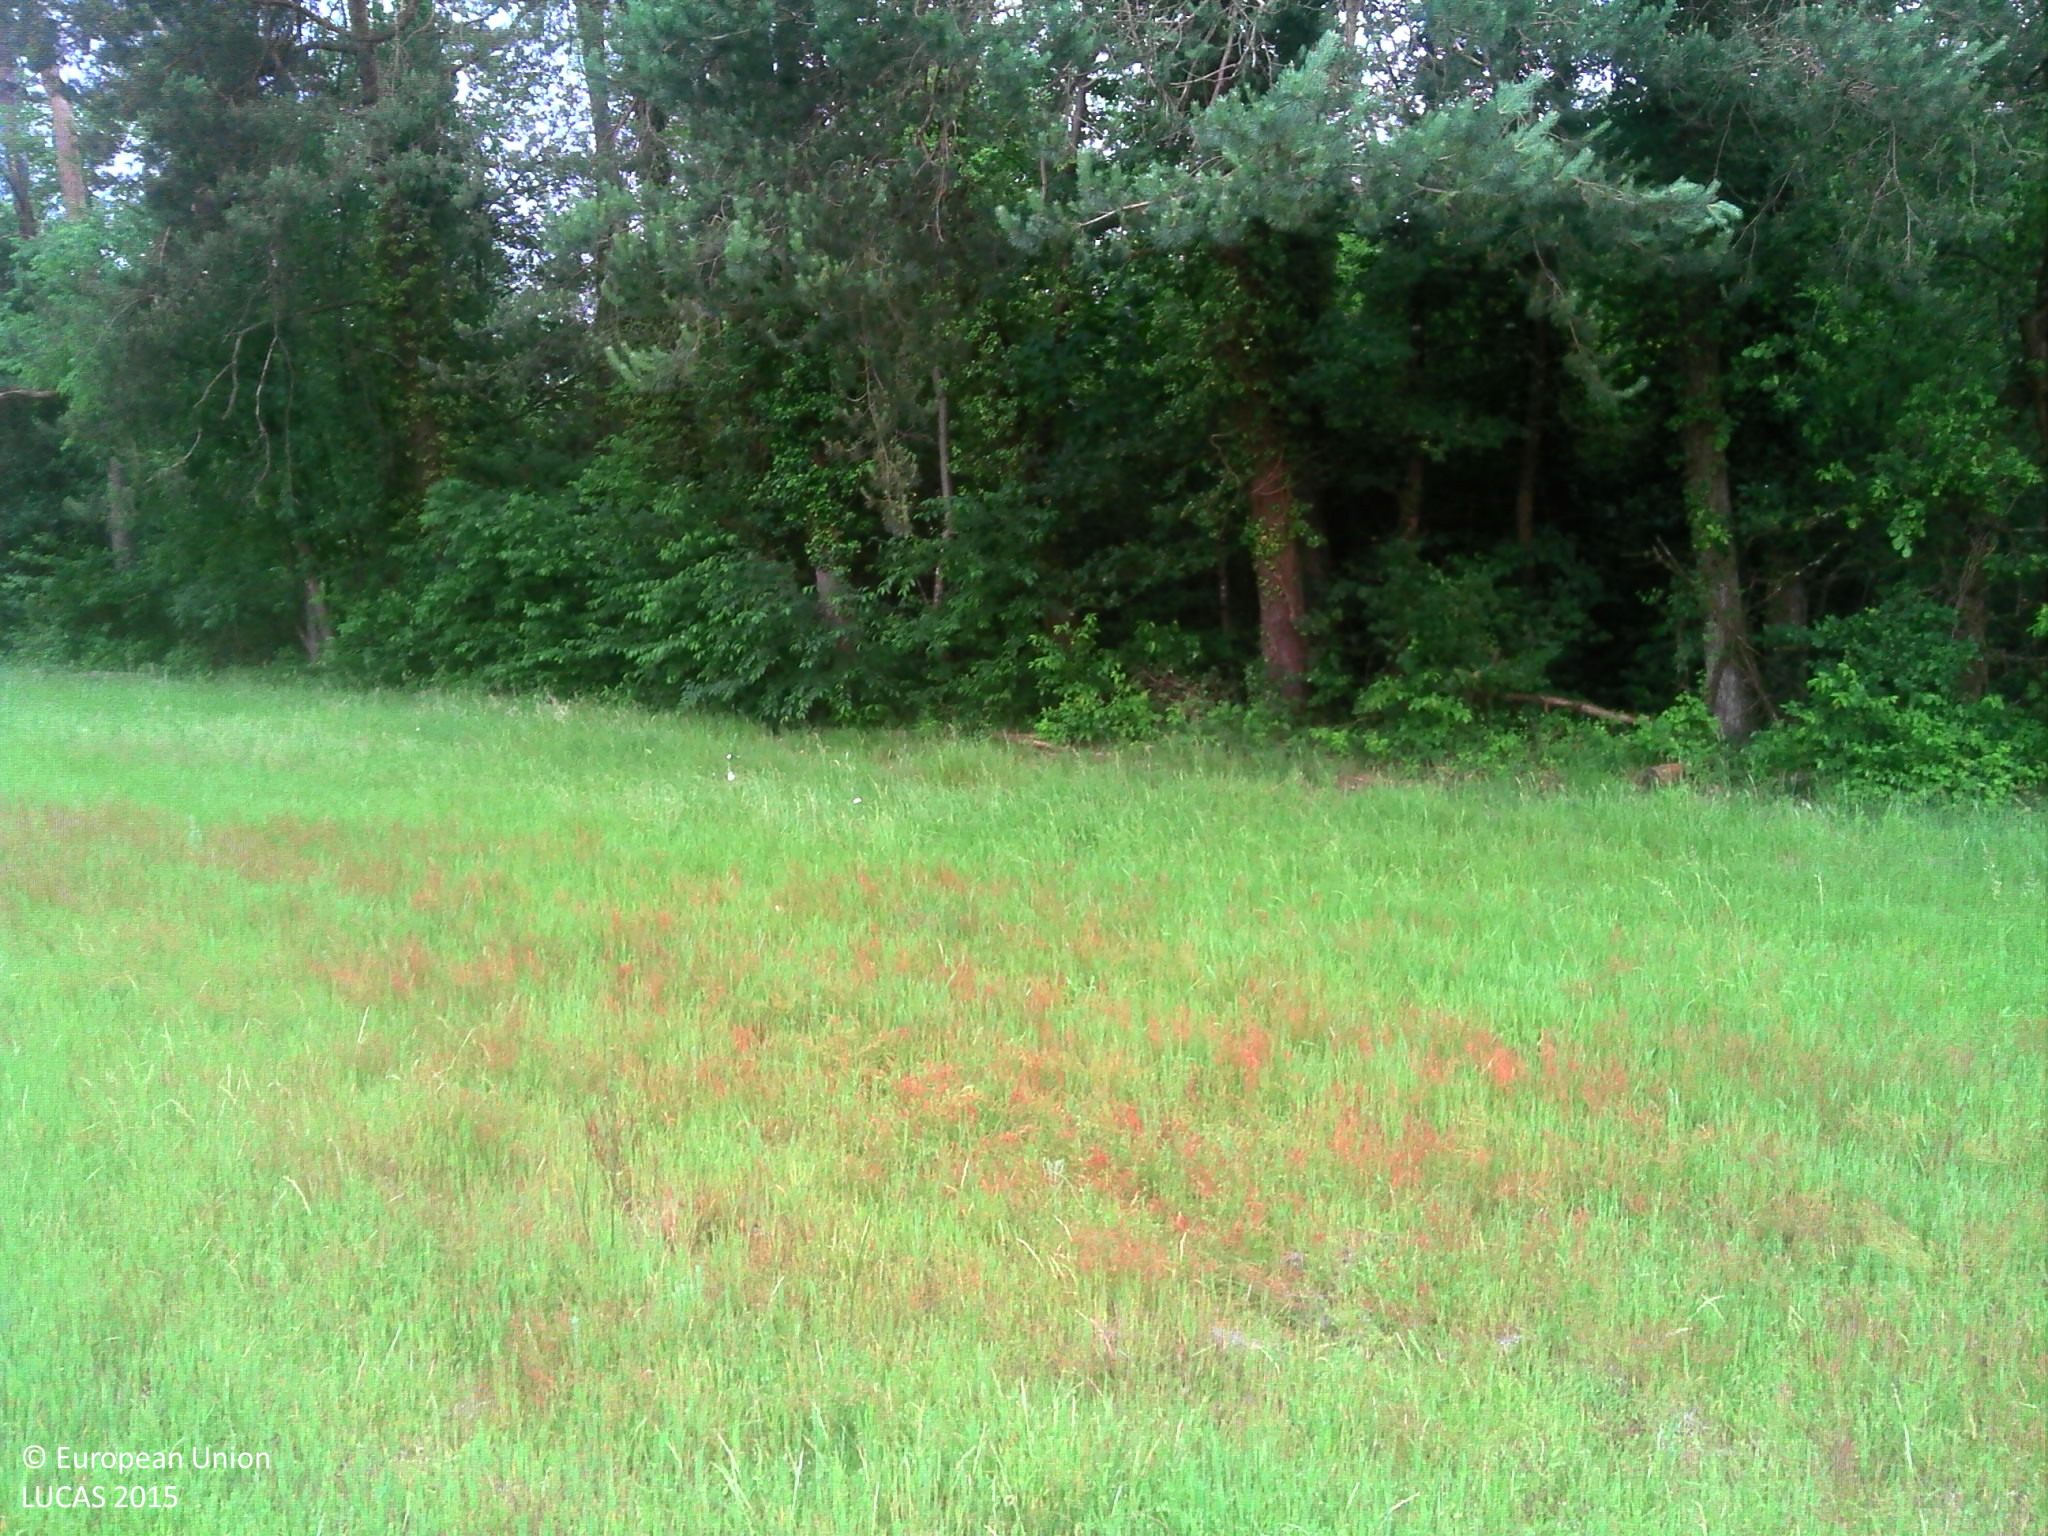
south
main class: Grassland
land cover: Grassland without tree/shrub cover
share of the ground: > 75 %
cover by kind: herbaceous plants 100 %
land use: Agriculture (excluding fallow land and kitchen gardens)
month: June
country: FR
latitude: 47.4534
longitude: 2.1249
